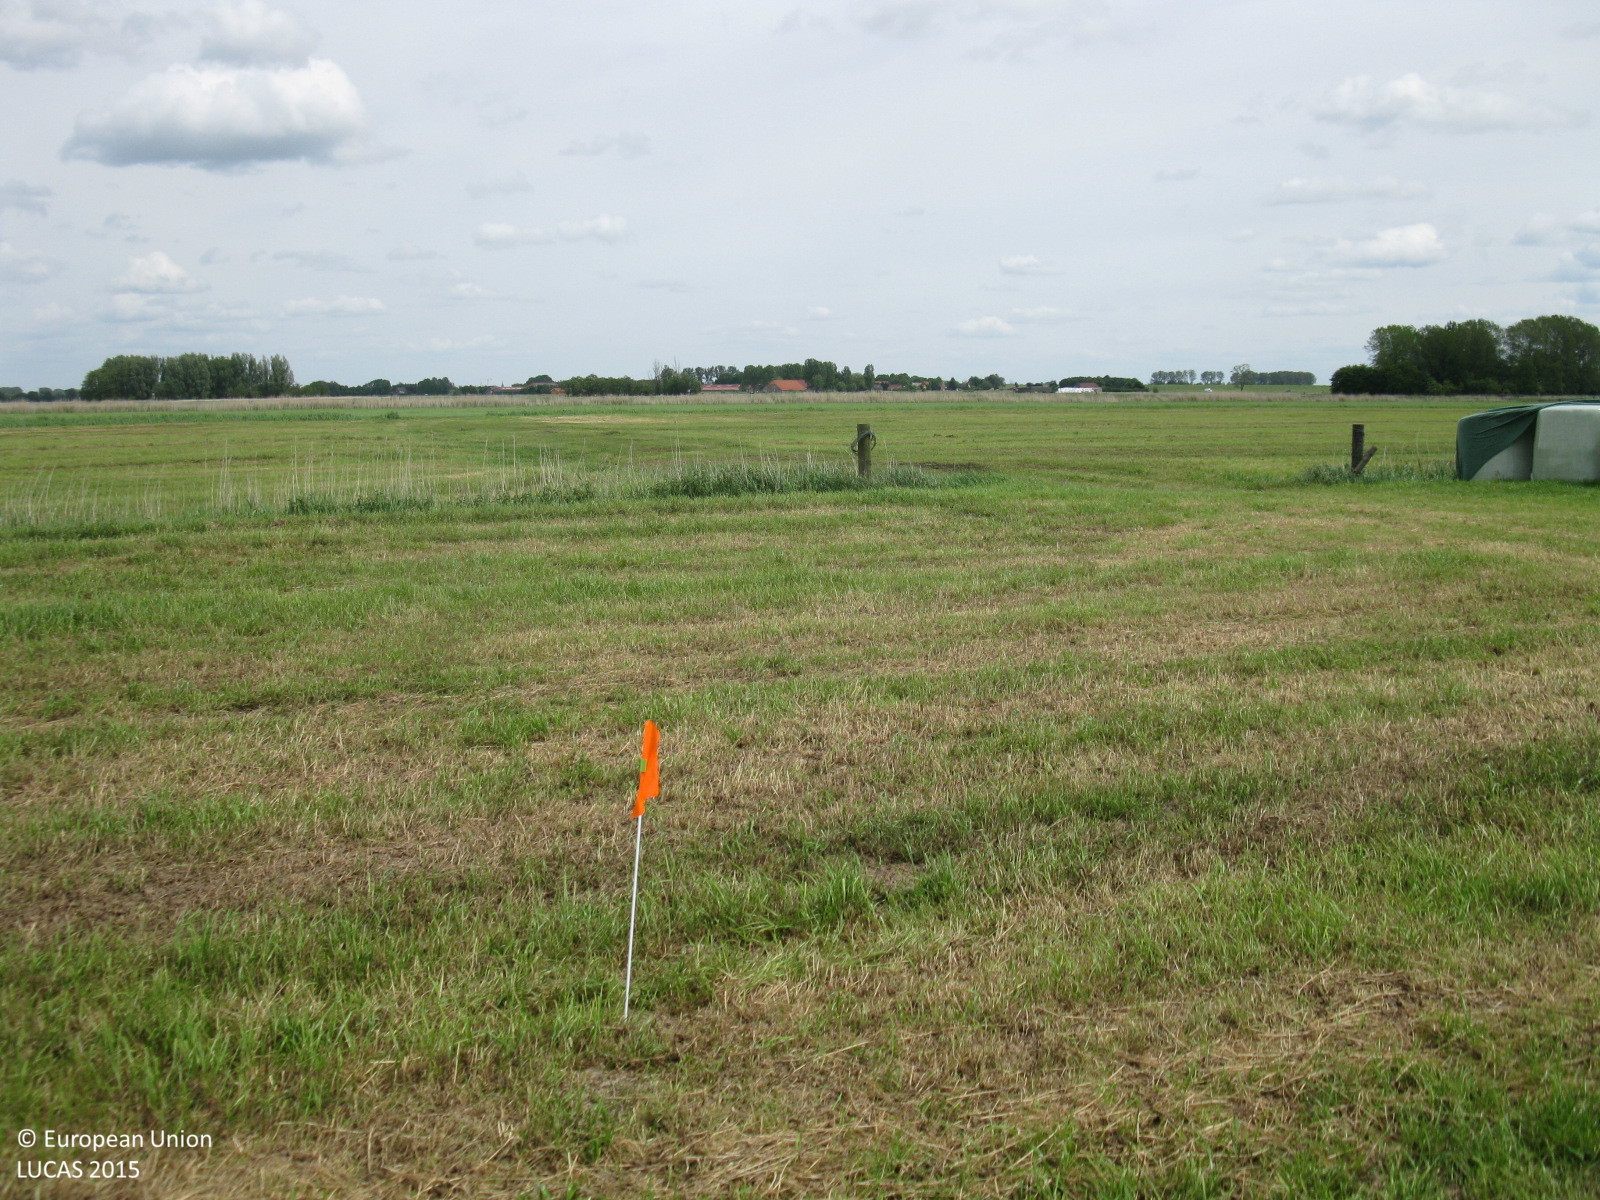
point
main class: Grassland
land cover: Grassland without tree/shrub cover
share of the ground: > 75 %
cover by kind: herbaceous plants 100 %
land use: Agriculture (excluding fallow land and kitchen gardens)
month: June
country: DE
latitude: 53.1938
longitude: 7.3812
